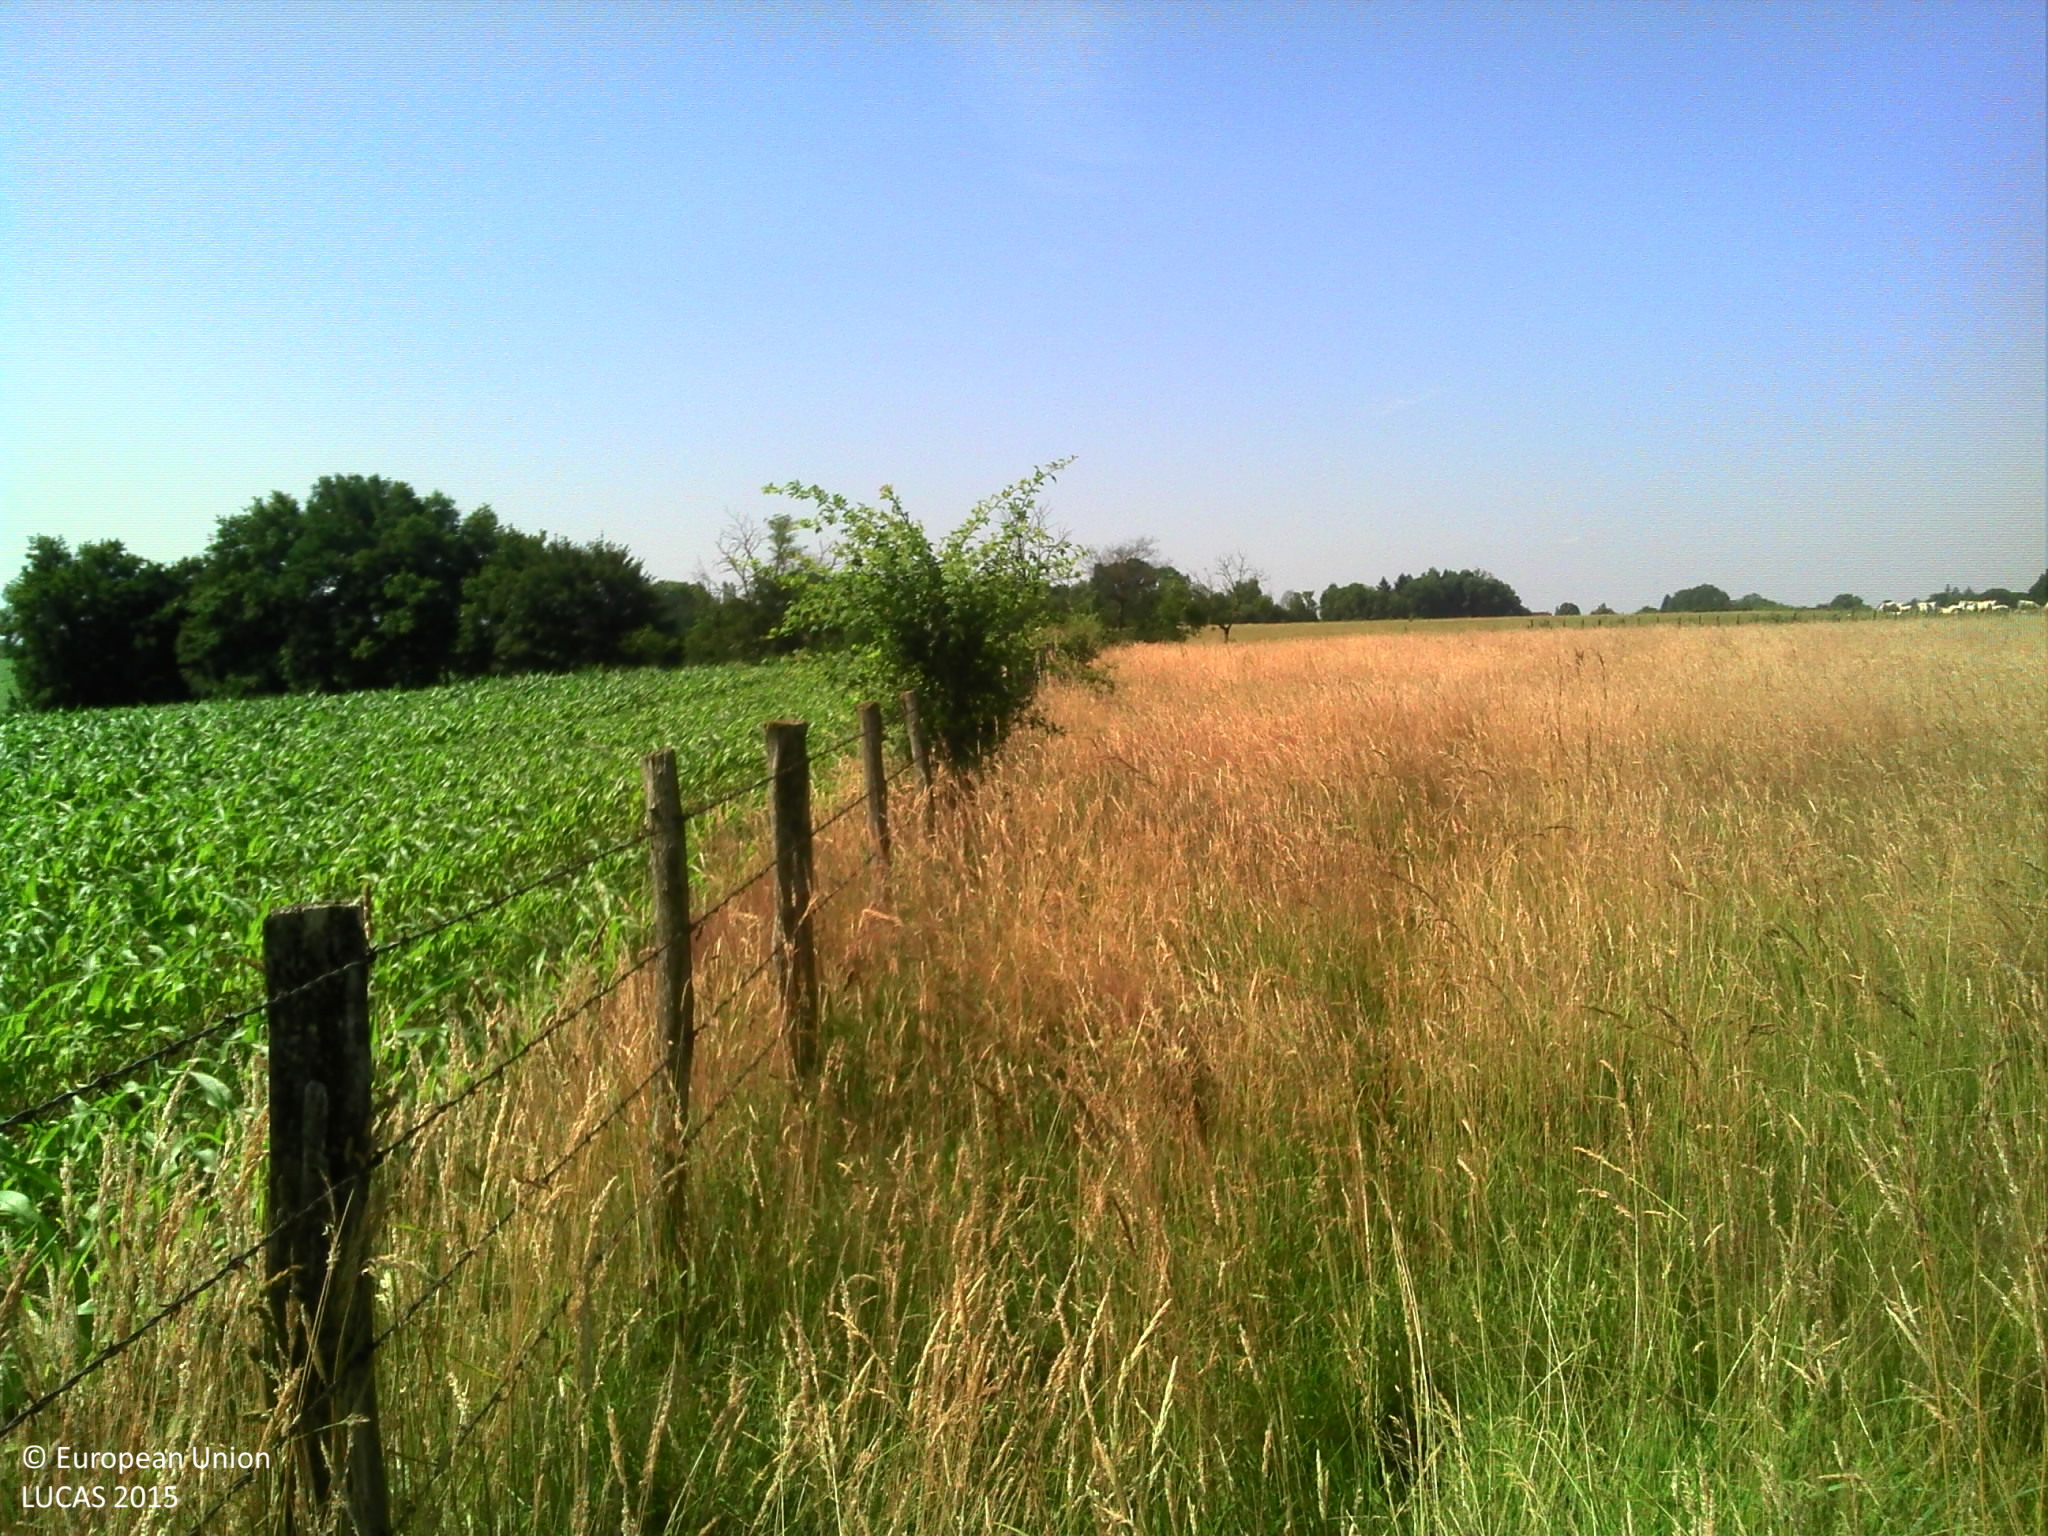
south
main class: Grassland
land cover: Grassland without tree/shrub cover
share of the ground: > 75 %
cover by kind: herbaceous plants 100 %
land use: Agriculture (excluding fallow land and kitchen gardens)
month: June
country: FR
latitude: 46.7543
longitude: 5.3284
